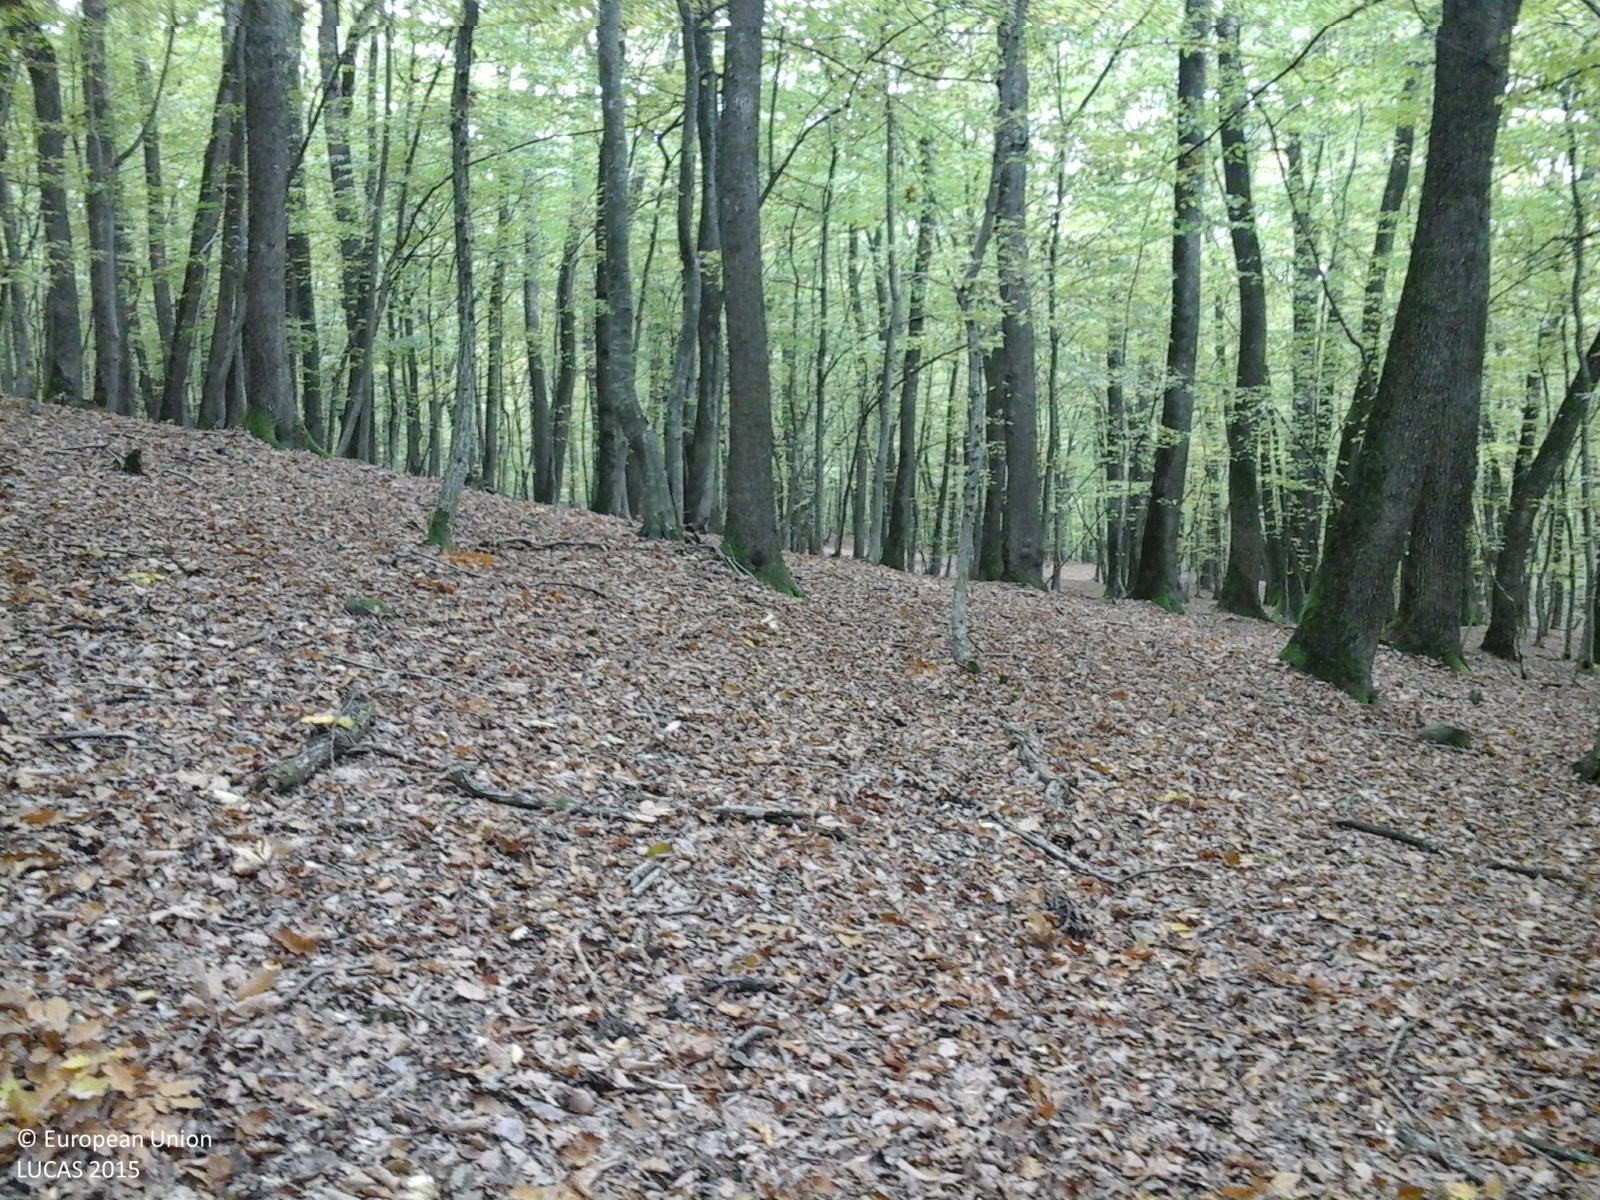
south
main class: Woodland
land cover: Broadleaved woodland
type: acidophilous oak and oak-birch forest
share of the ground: > 75 %
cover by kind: broadleaved forest trees 100 %
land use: Forestry
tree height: > 5 m
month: October
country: RO
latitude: 46.6369
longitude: 24.8965
